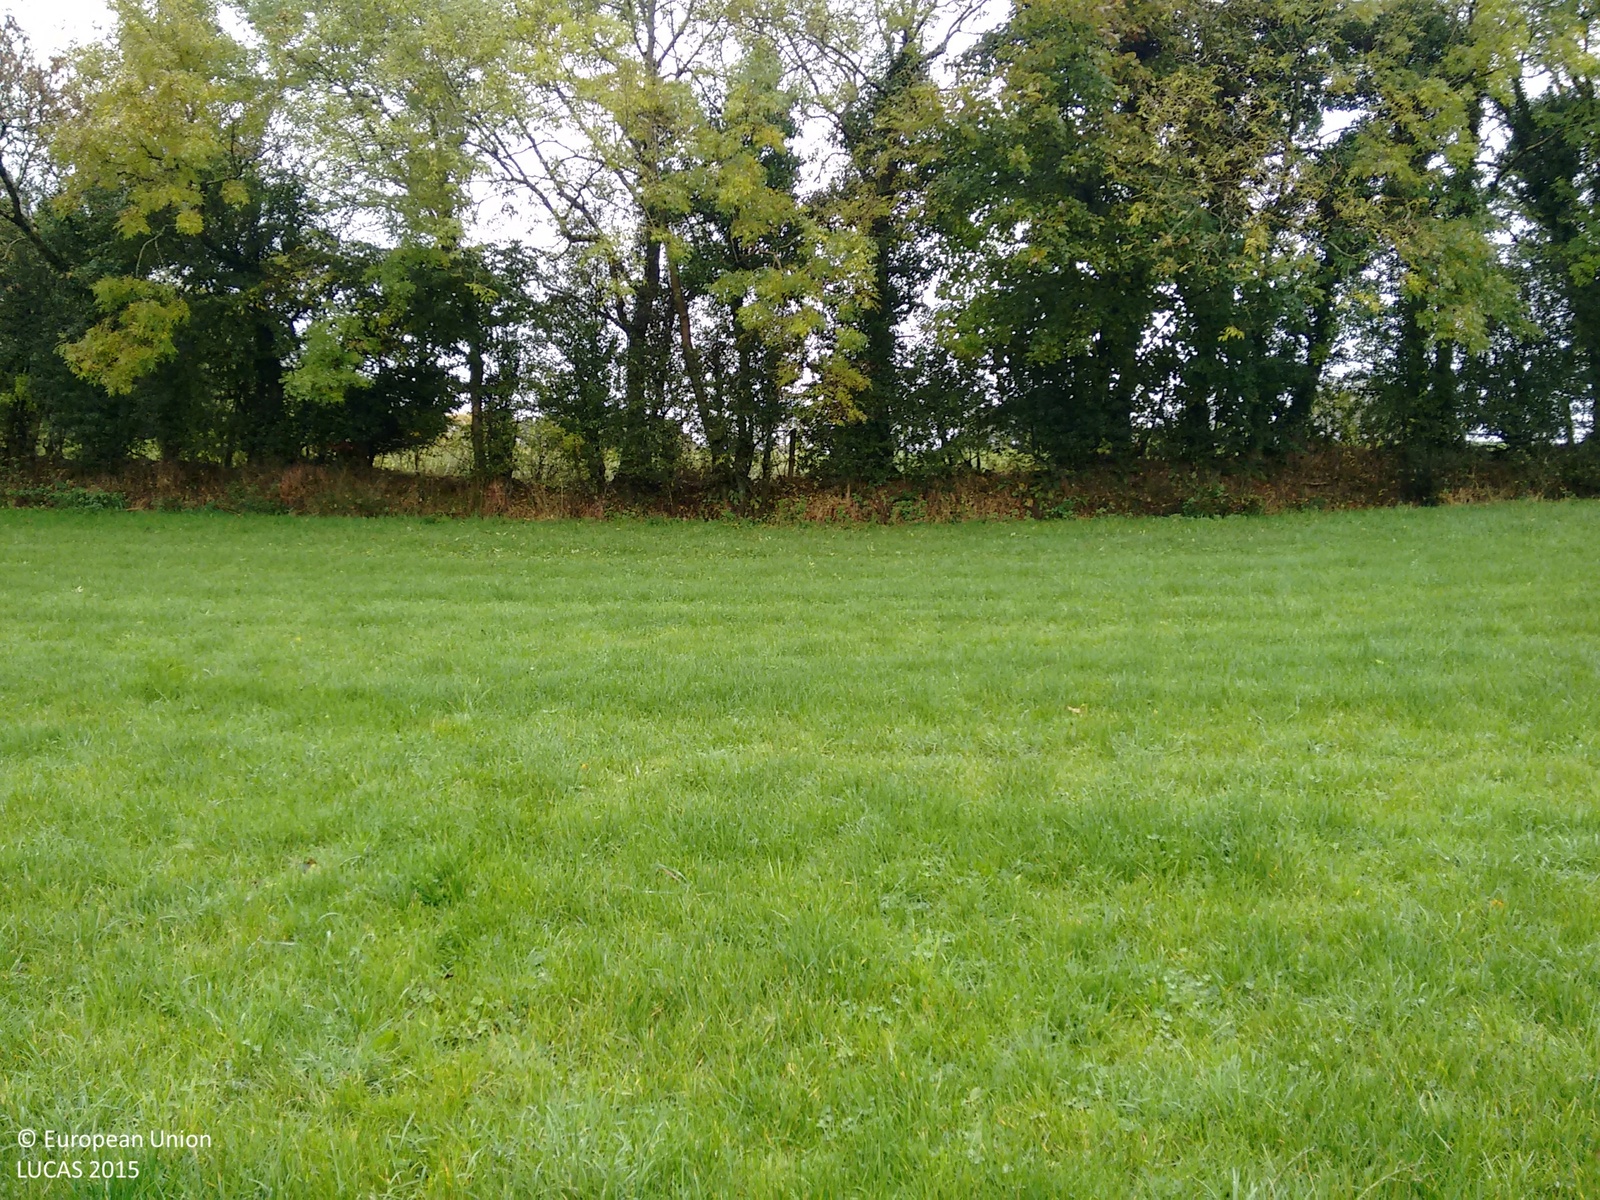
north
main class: Grassland
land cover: Grassland without tree/shrub cover
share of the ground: > 75 %
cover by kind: herbaceous plants 100 %
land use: Agriculture (excluding fallow land and kitchen gardens)
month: October
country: GB
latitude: 54.5568
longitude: -7.4251
